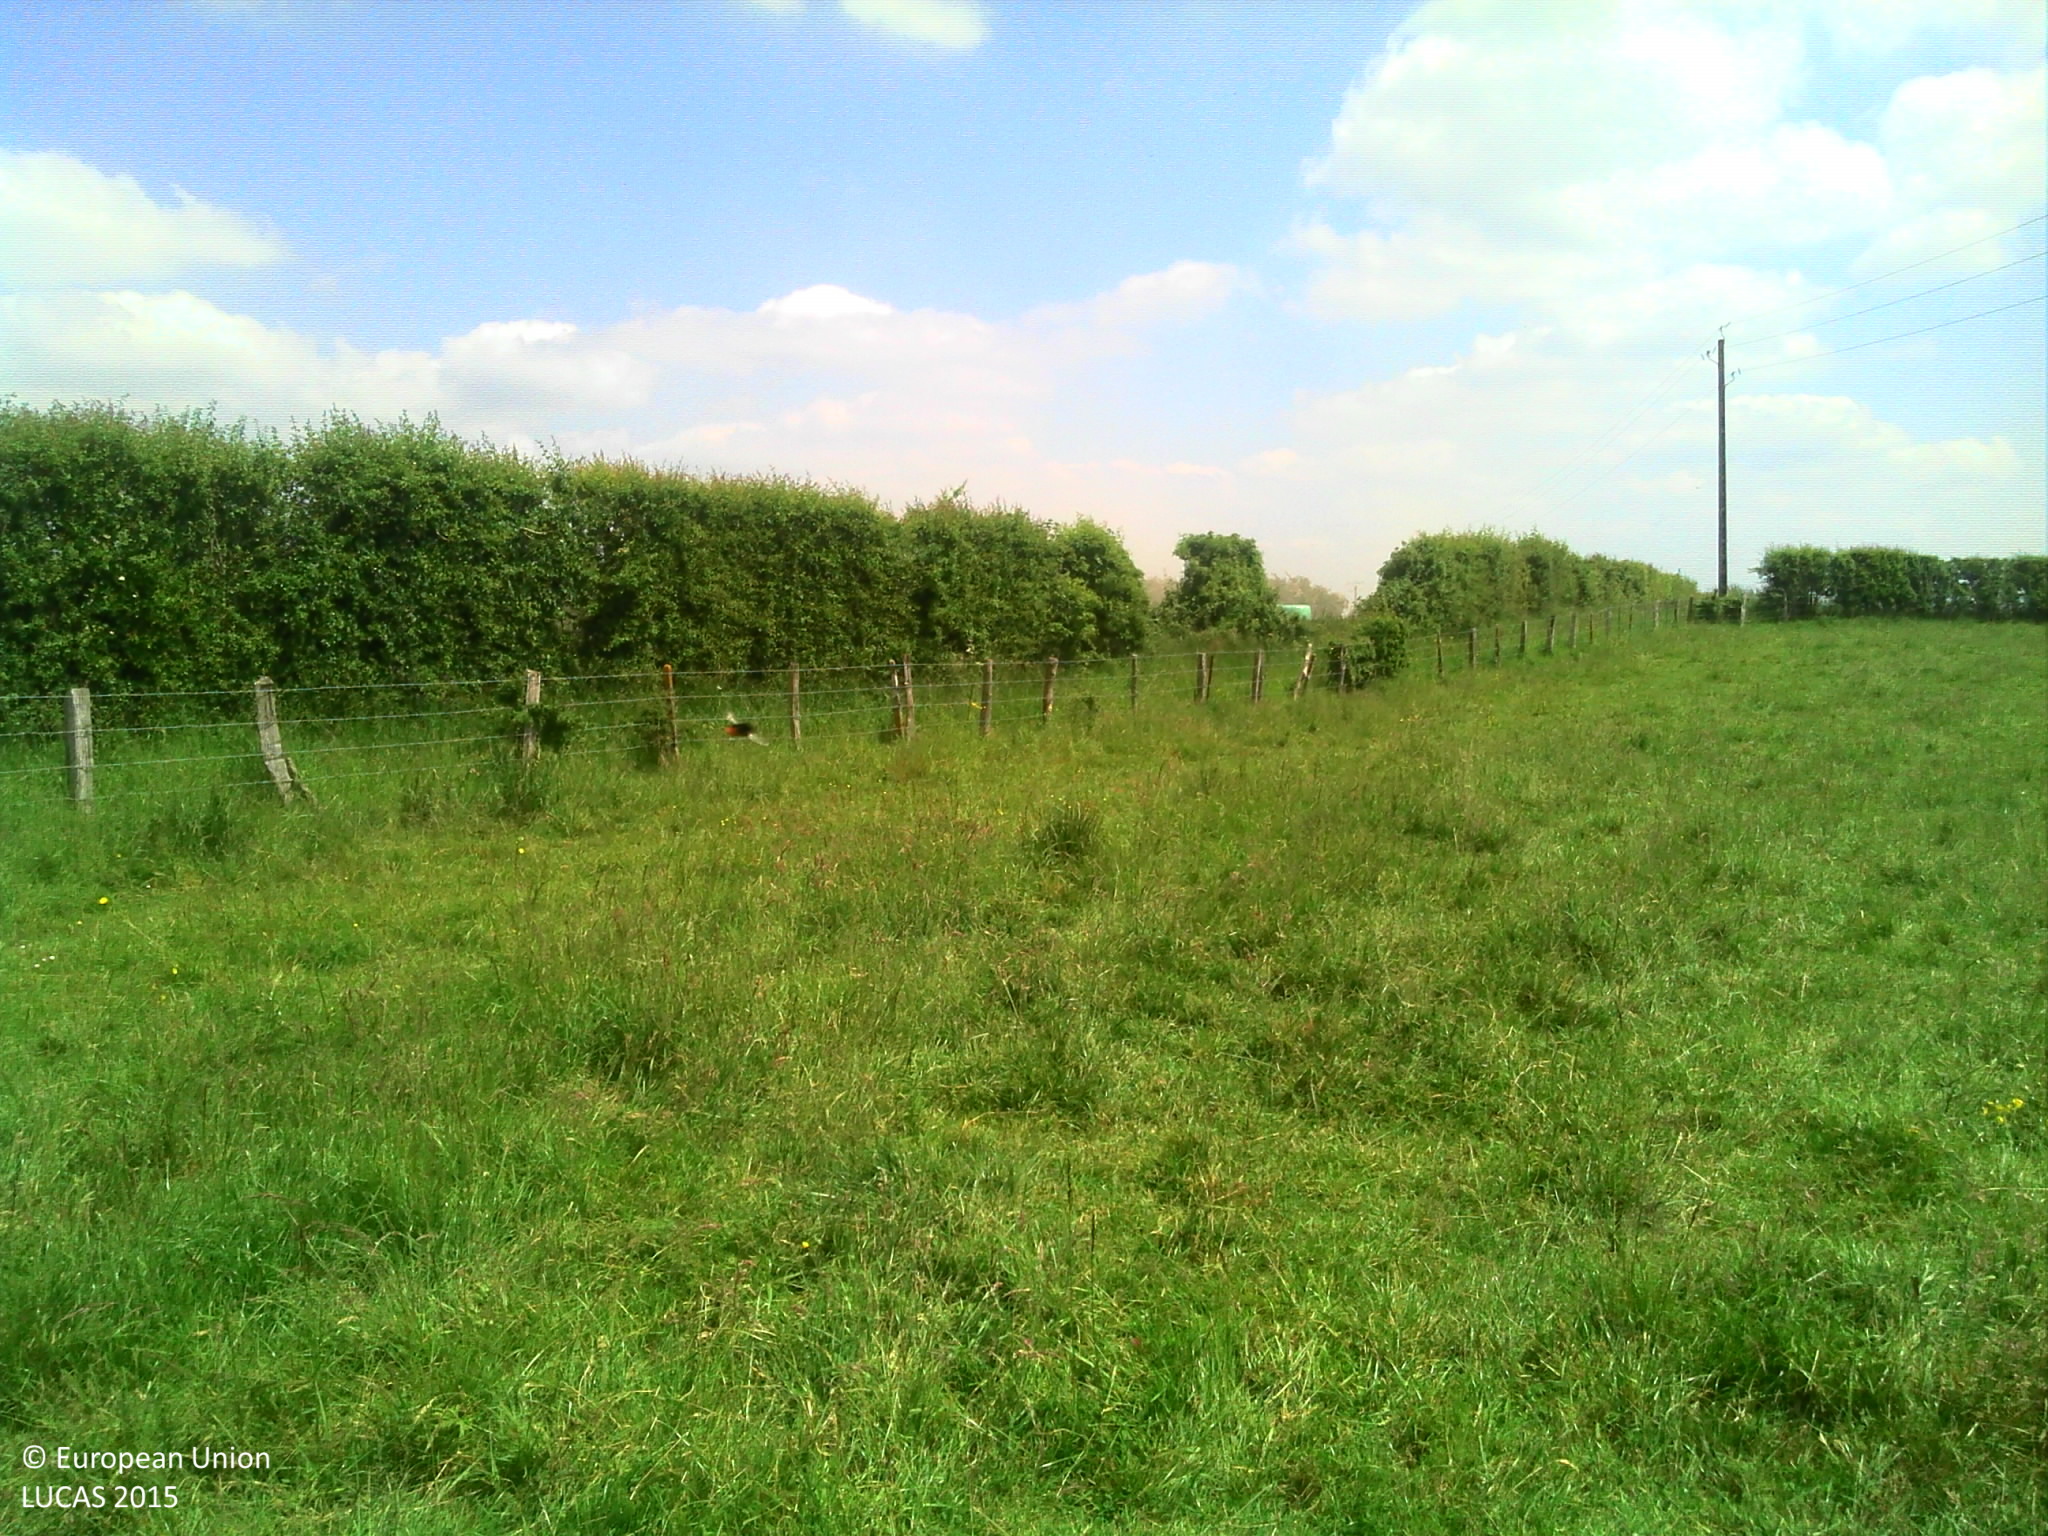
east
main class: Grassland
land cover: Grassland without tree/shrub cover
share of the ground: > 75 %
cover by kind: herbaceous plants 75 %
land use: Agriculture (excluding fallow land and kitchen gardens)
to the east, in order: Grassland without tree/shrub cover; Fences; Tracks; Managed hedges; Mixed cereals for fodder; Managed hedges; Rape and turnip rape
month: May
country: FR
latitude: 48.7523
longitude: -0.1374
